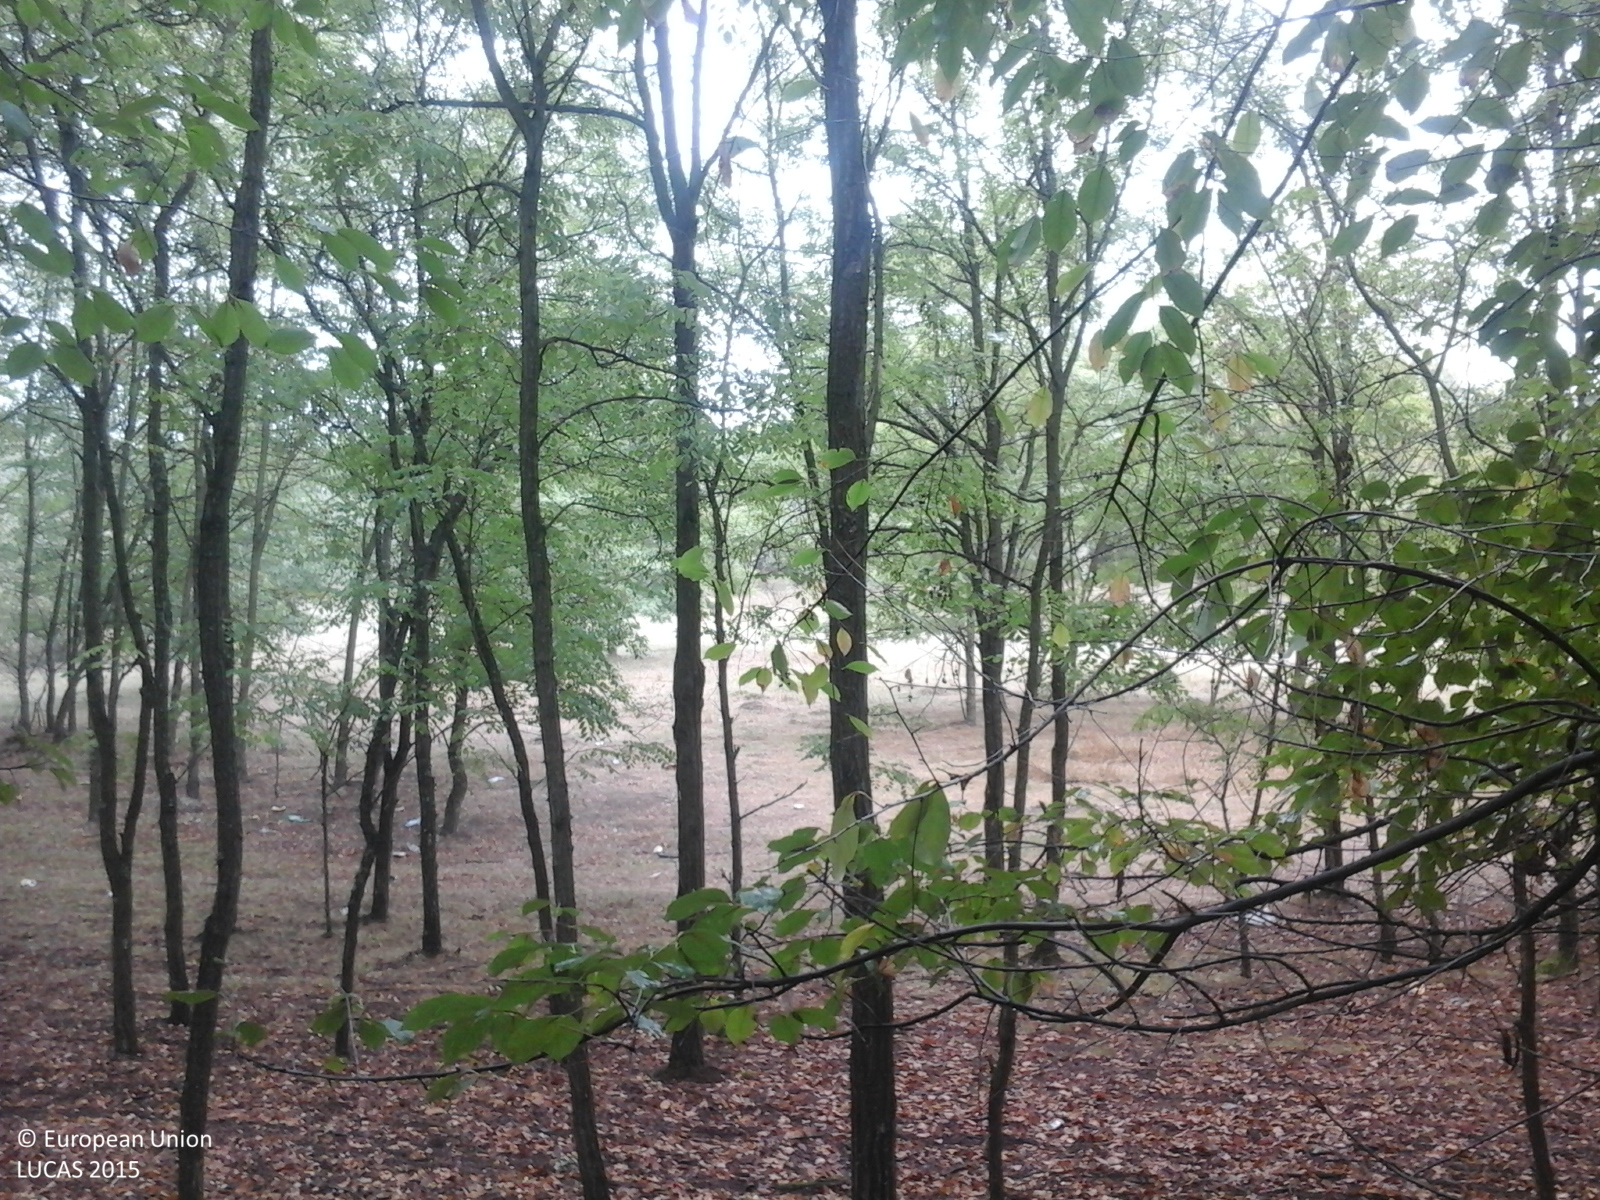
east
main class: Woodland
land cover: Broadleaved woodland
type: mesophytic deciduous forest
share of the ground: > 75 %
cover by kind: broadleaved forest trees 100 %
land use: Forestry
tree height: > 5 m
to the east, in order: Broadleaved woodland; Grassland without tree/shrub cover; Tracks; Grassland without tree/shrub cover; Broadleaved woodland; Grassland with sparse tree/shrub cover; Tracks; Grass margins; Vineyards; Broadleaved woodland
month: September
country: RO
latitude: 47.6630
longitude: 22.2654
